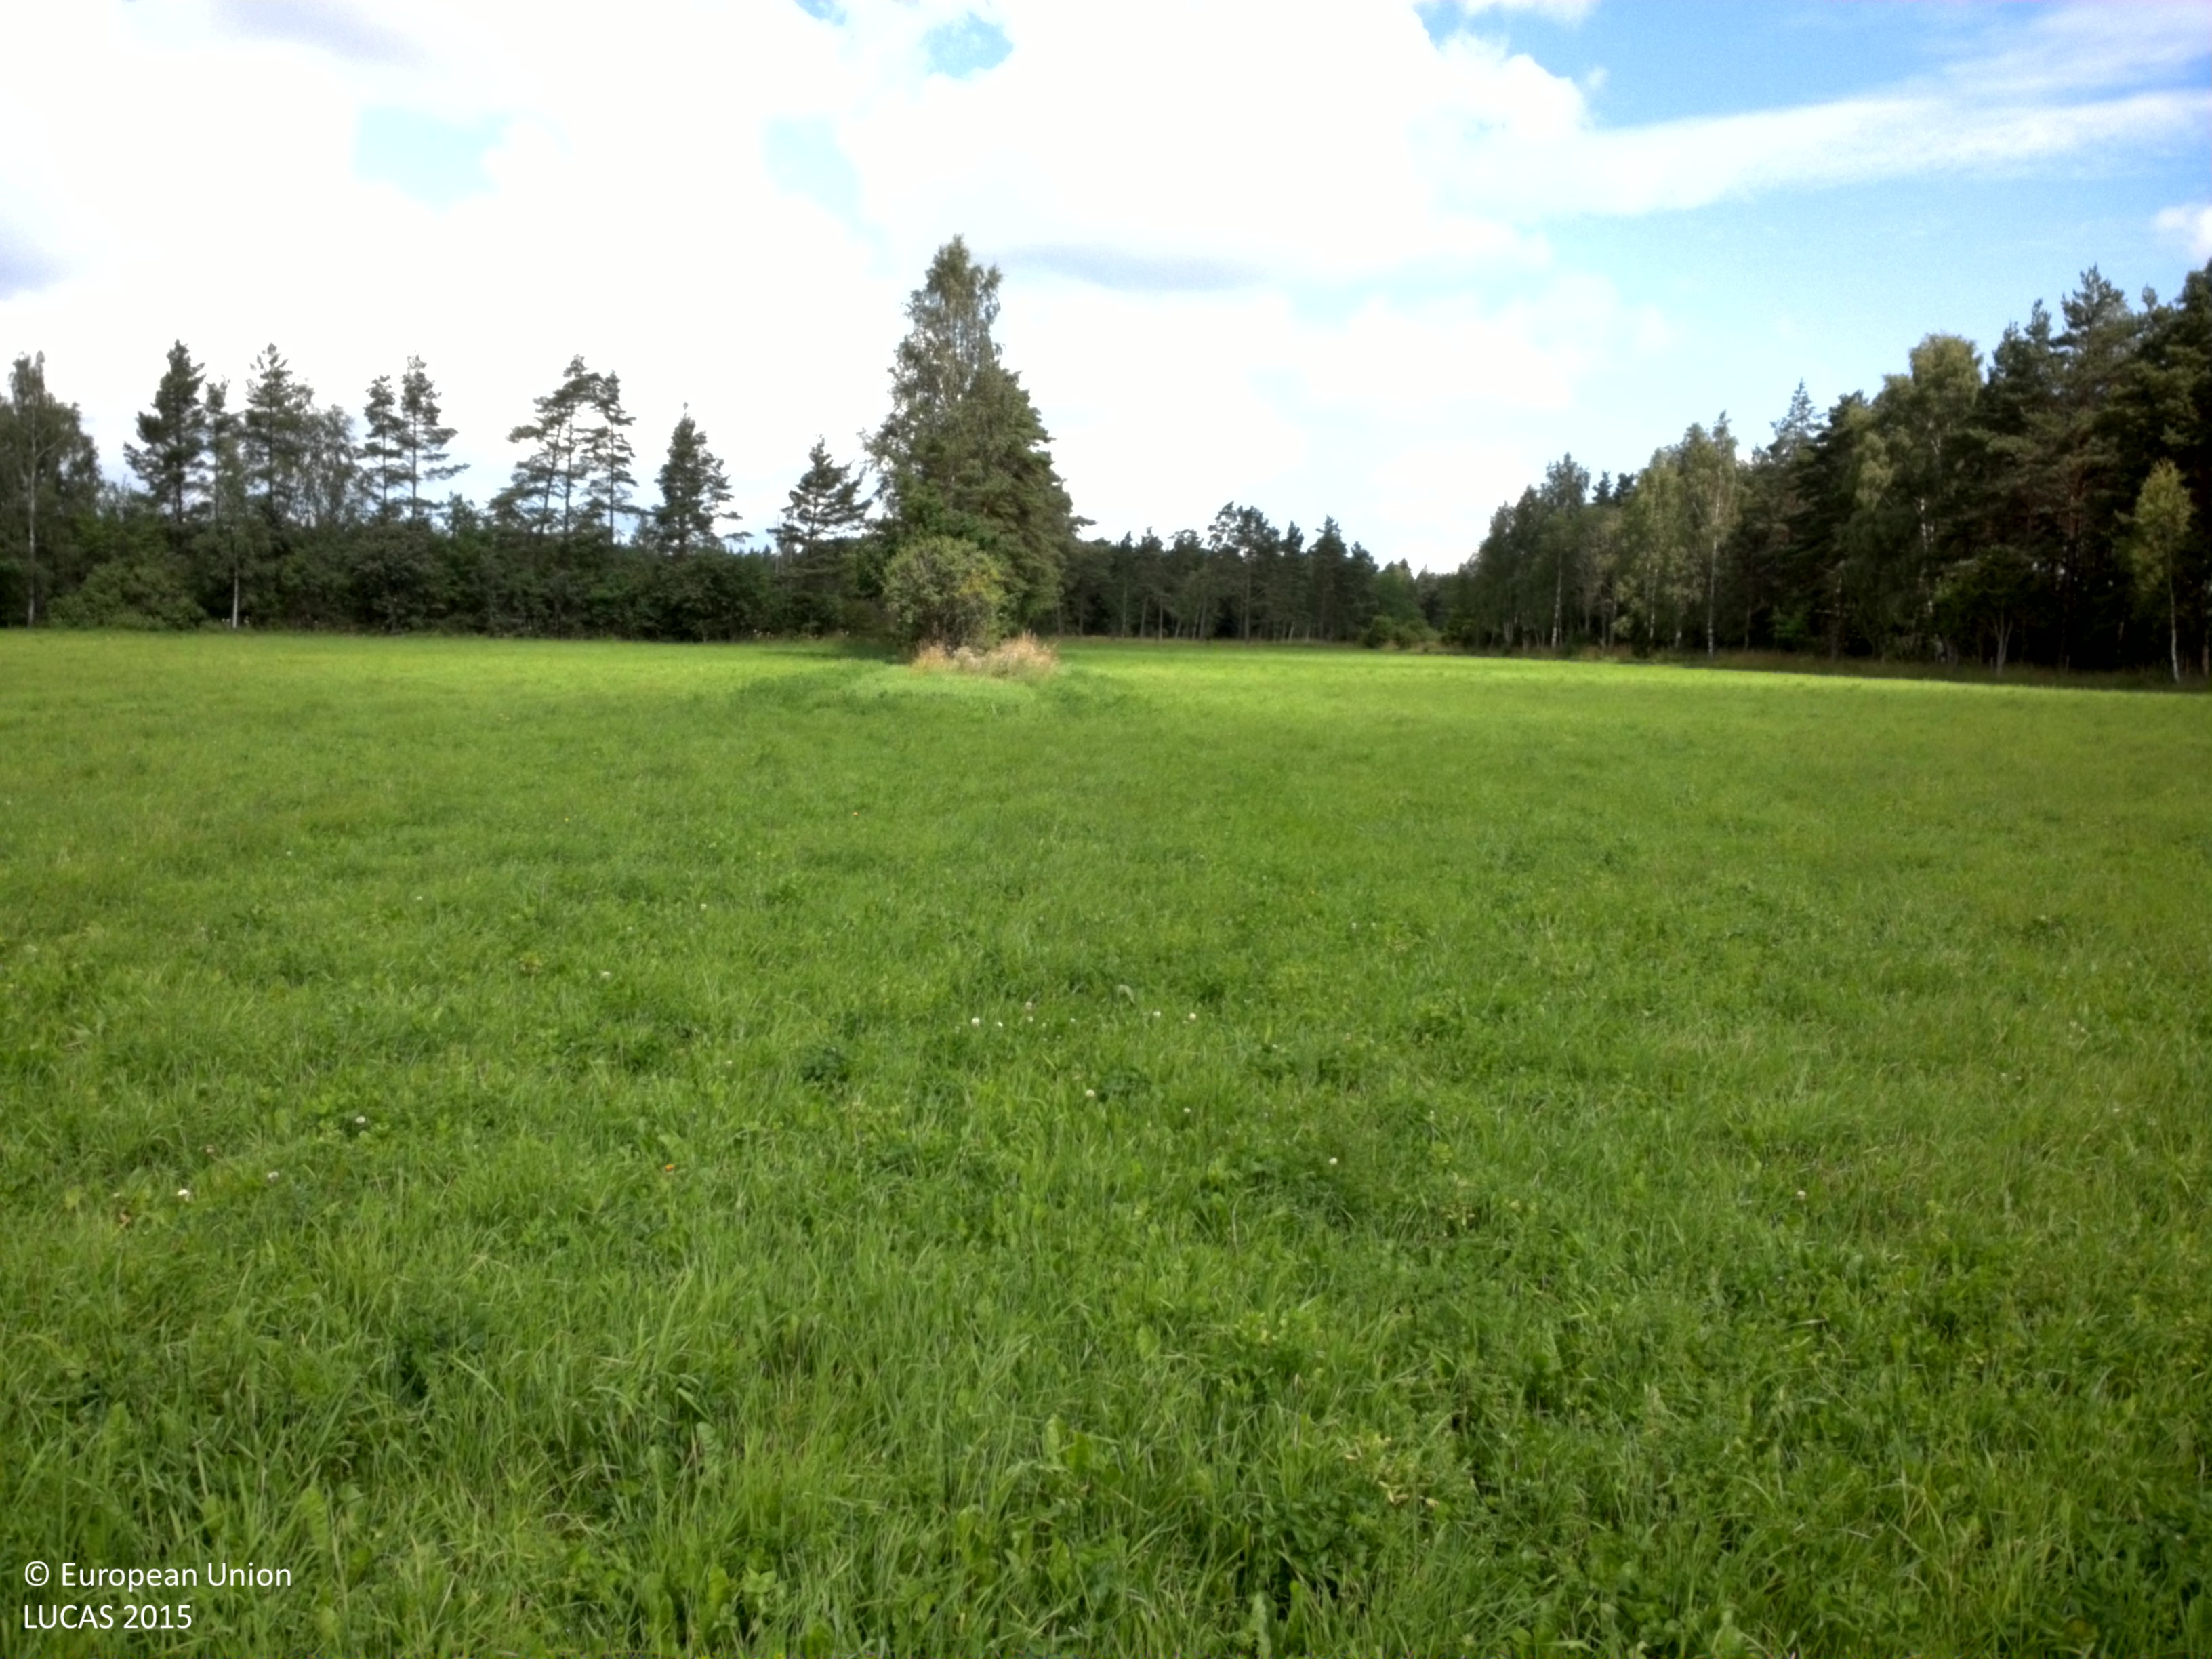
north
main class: Grassland
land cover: Grassland without tree/shrub cover
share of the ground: > 75 %
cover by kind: herbaceous plants 100 %
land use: Agriculture (excluding fallow land and kitchen gardens)
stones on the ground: < 10 %
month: July
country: SE
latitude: 57.5688
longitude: 18.5183
